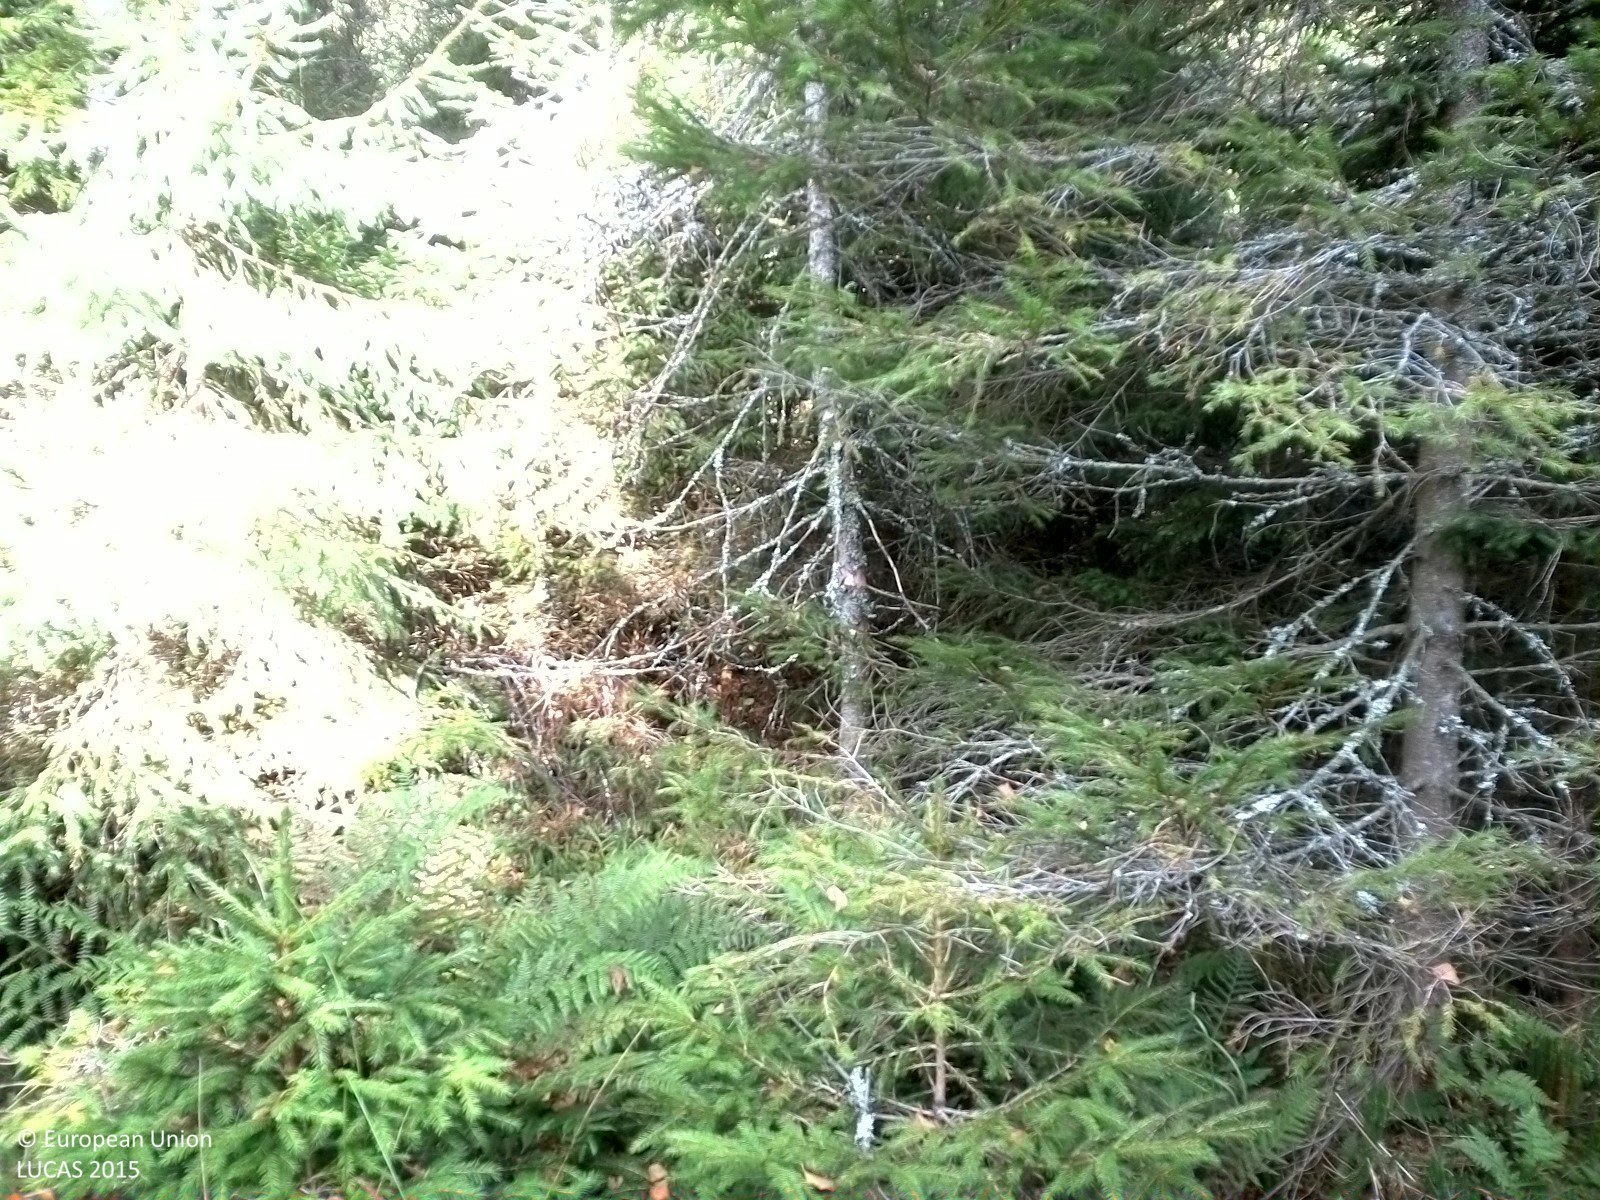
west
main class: Grassland
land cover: Grassland without tree/shrub cover
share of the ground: > 75 %
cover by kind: herbaceous plants 95 %, unconsolidated bare surface 5 %
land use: Amenities, museums, leisure
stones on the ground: < 10 %
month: August
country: SE
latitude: 59.0966
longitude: 15.5610
